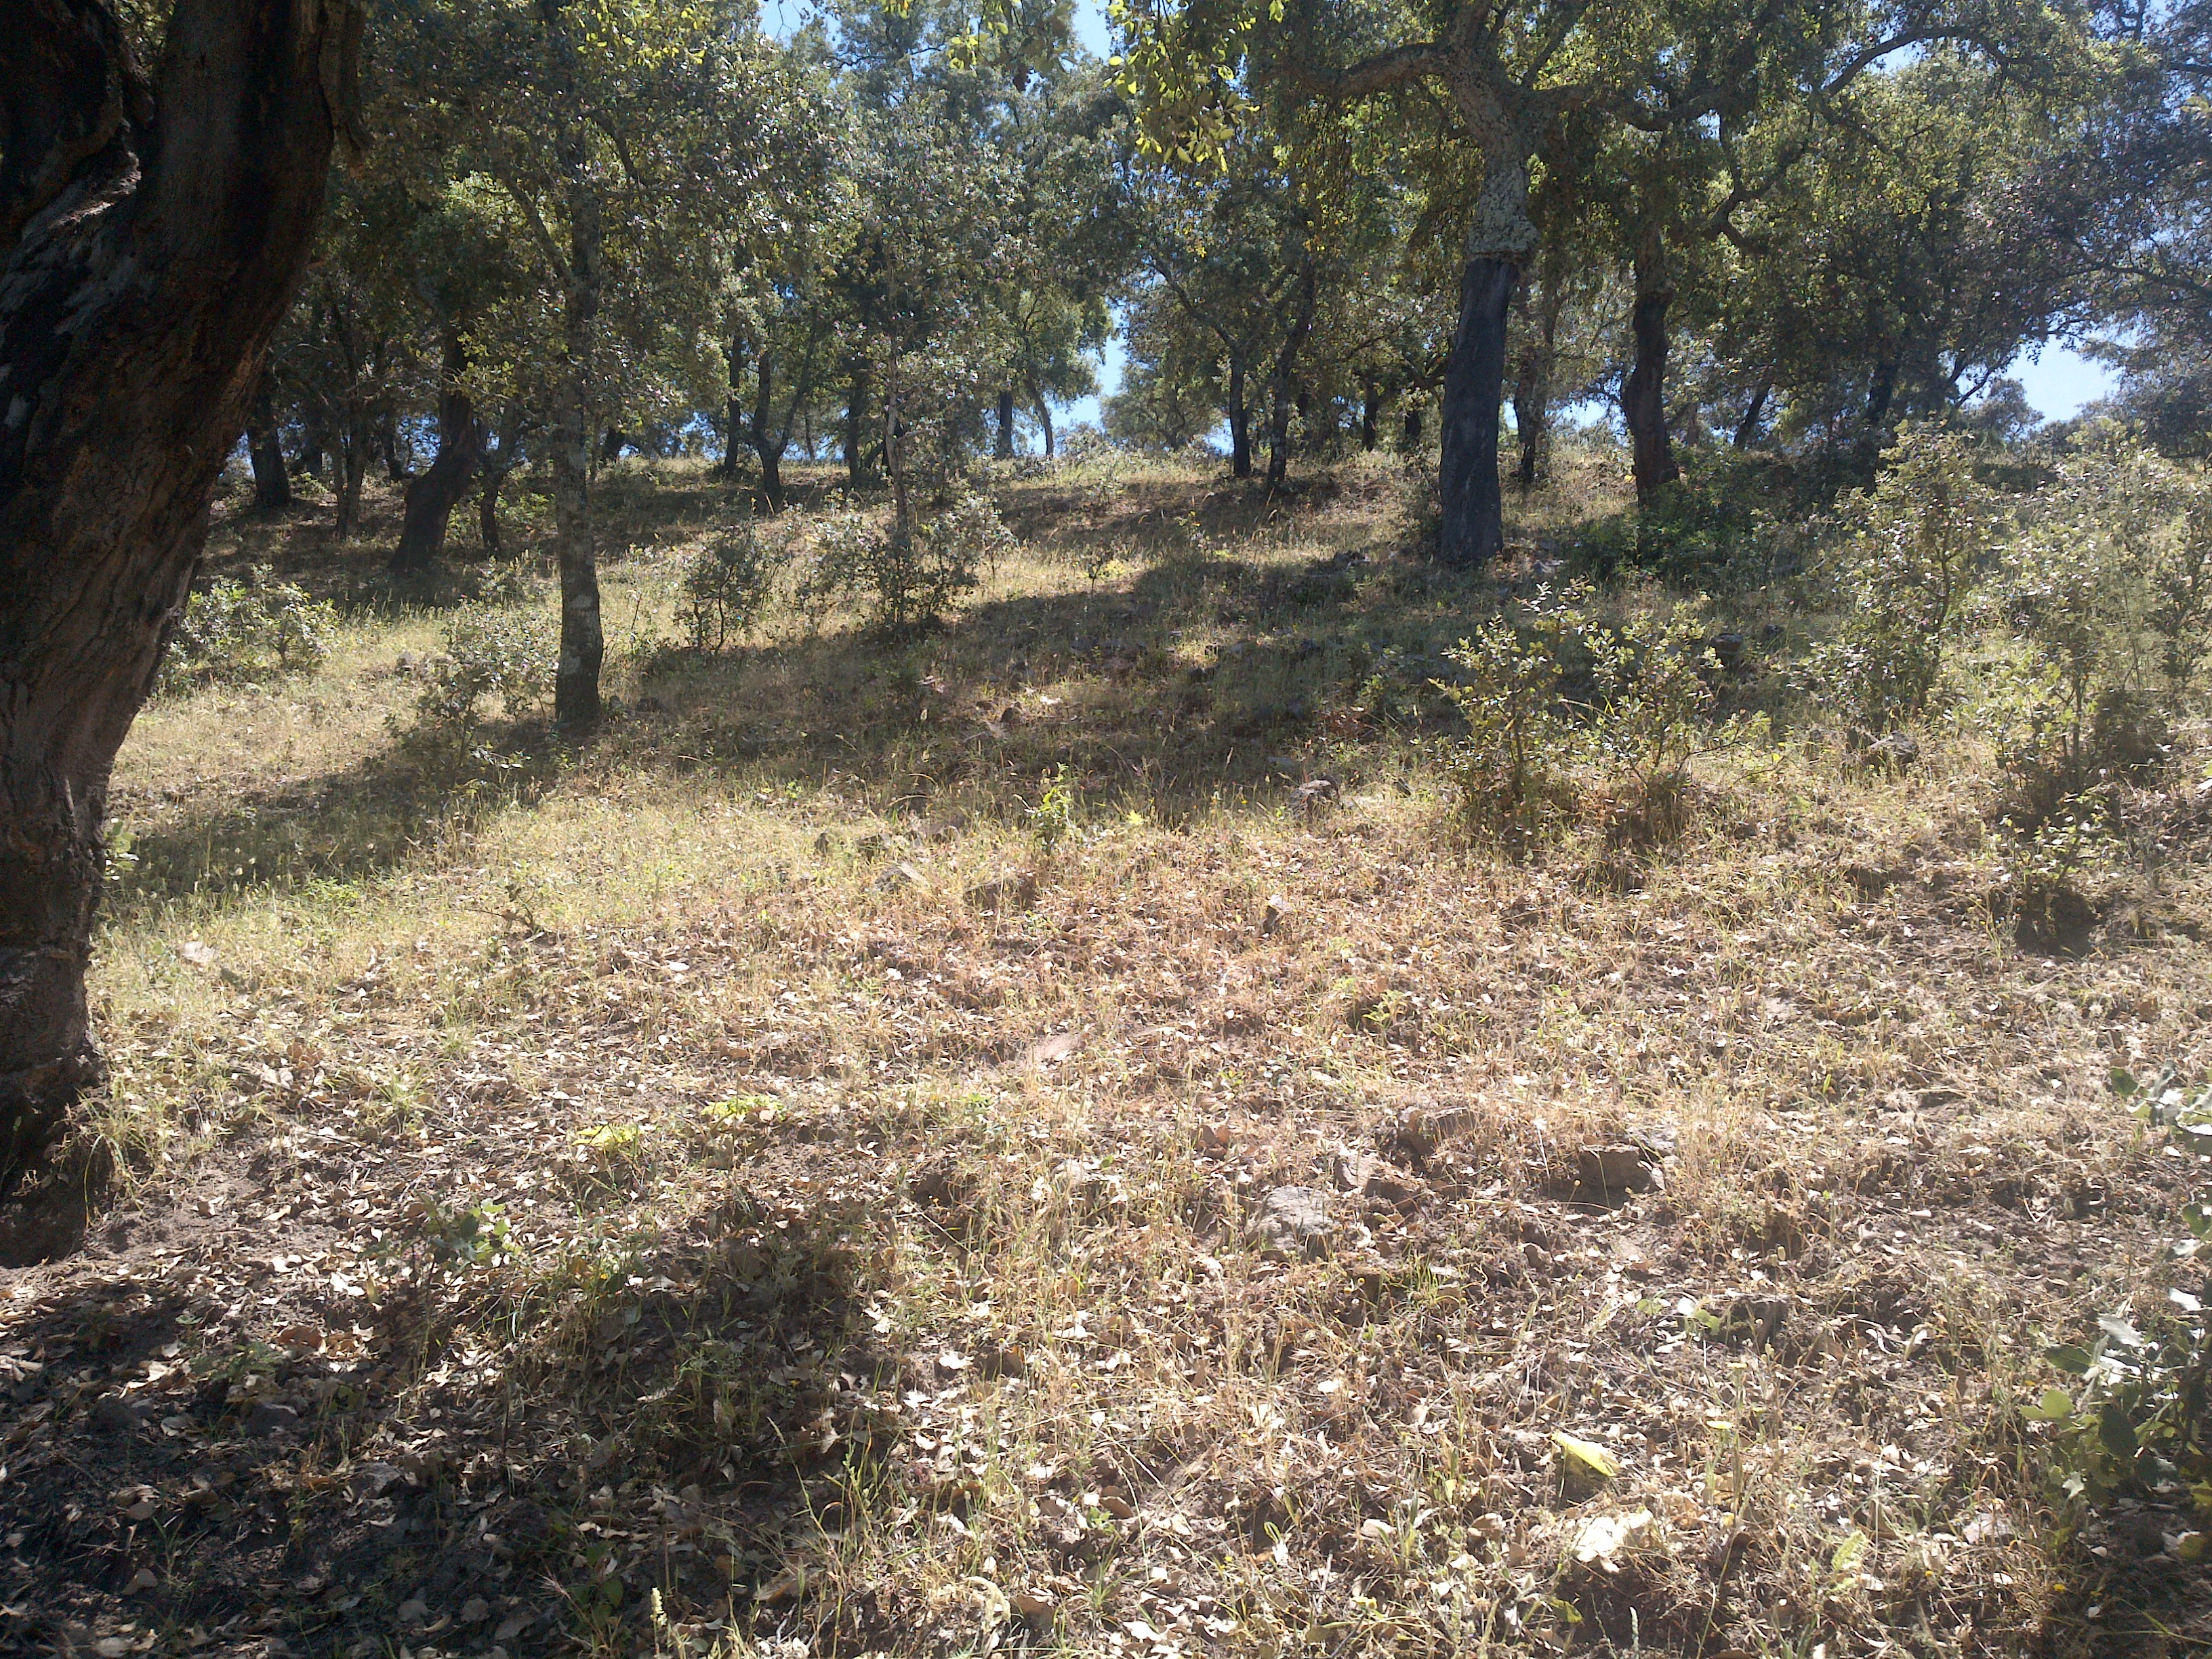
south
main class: Woodland
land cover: Broadleaved woodland
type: broadleaved evergreen forest
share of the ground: 50 - 75 %
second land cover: Spontaneously vegetated surfaces
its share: 10 - 25 %
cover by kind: broadleaved forest trees 60 %, shrubs 10 %, herbaceous plants 10 %, lichens and mosses 10 %, unconsolidated bare surface 10 %
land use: Forestry
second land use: Agriculture (excluding fallow land and kitchen gardens)
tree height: > 5 m
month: May
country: ES
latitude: 37.9195
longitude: -4.9534
